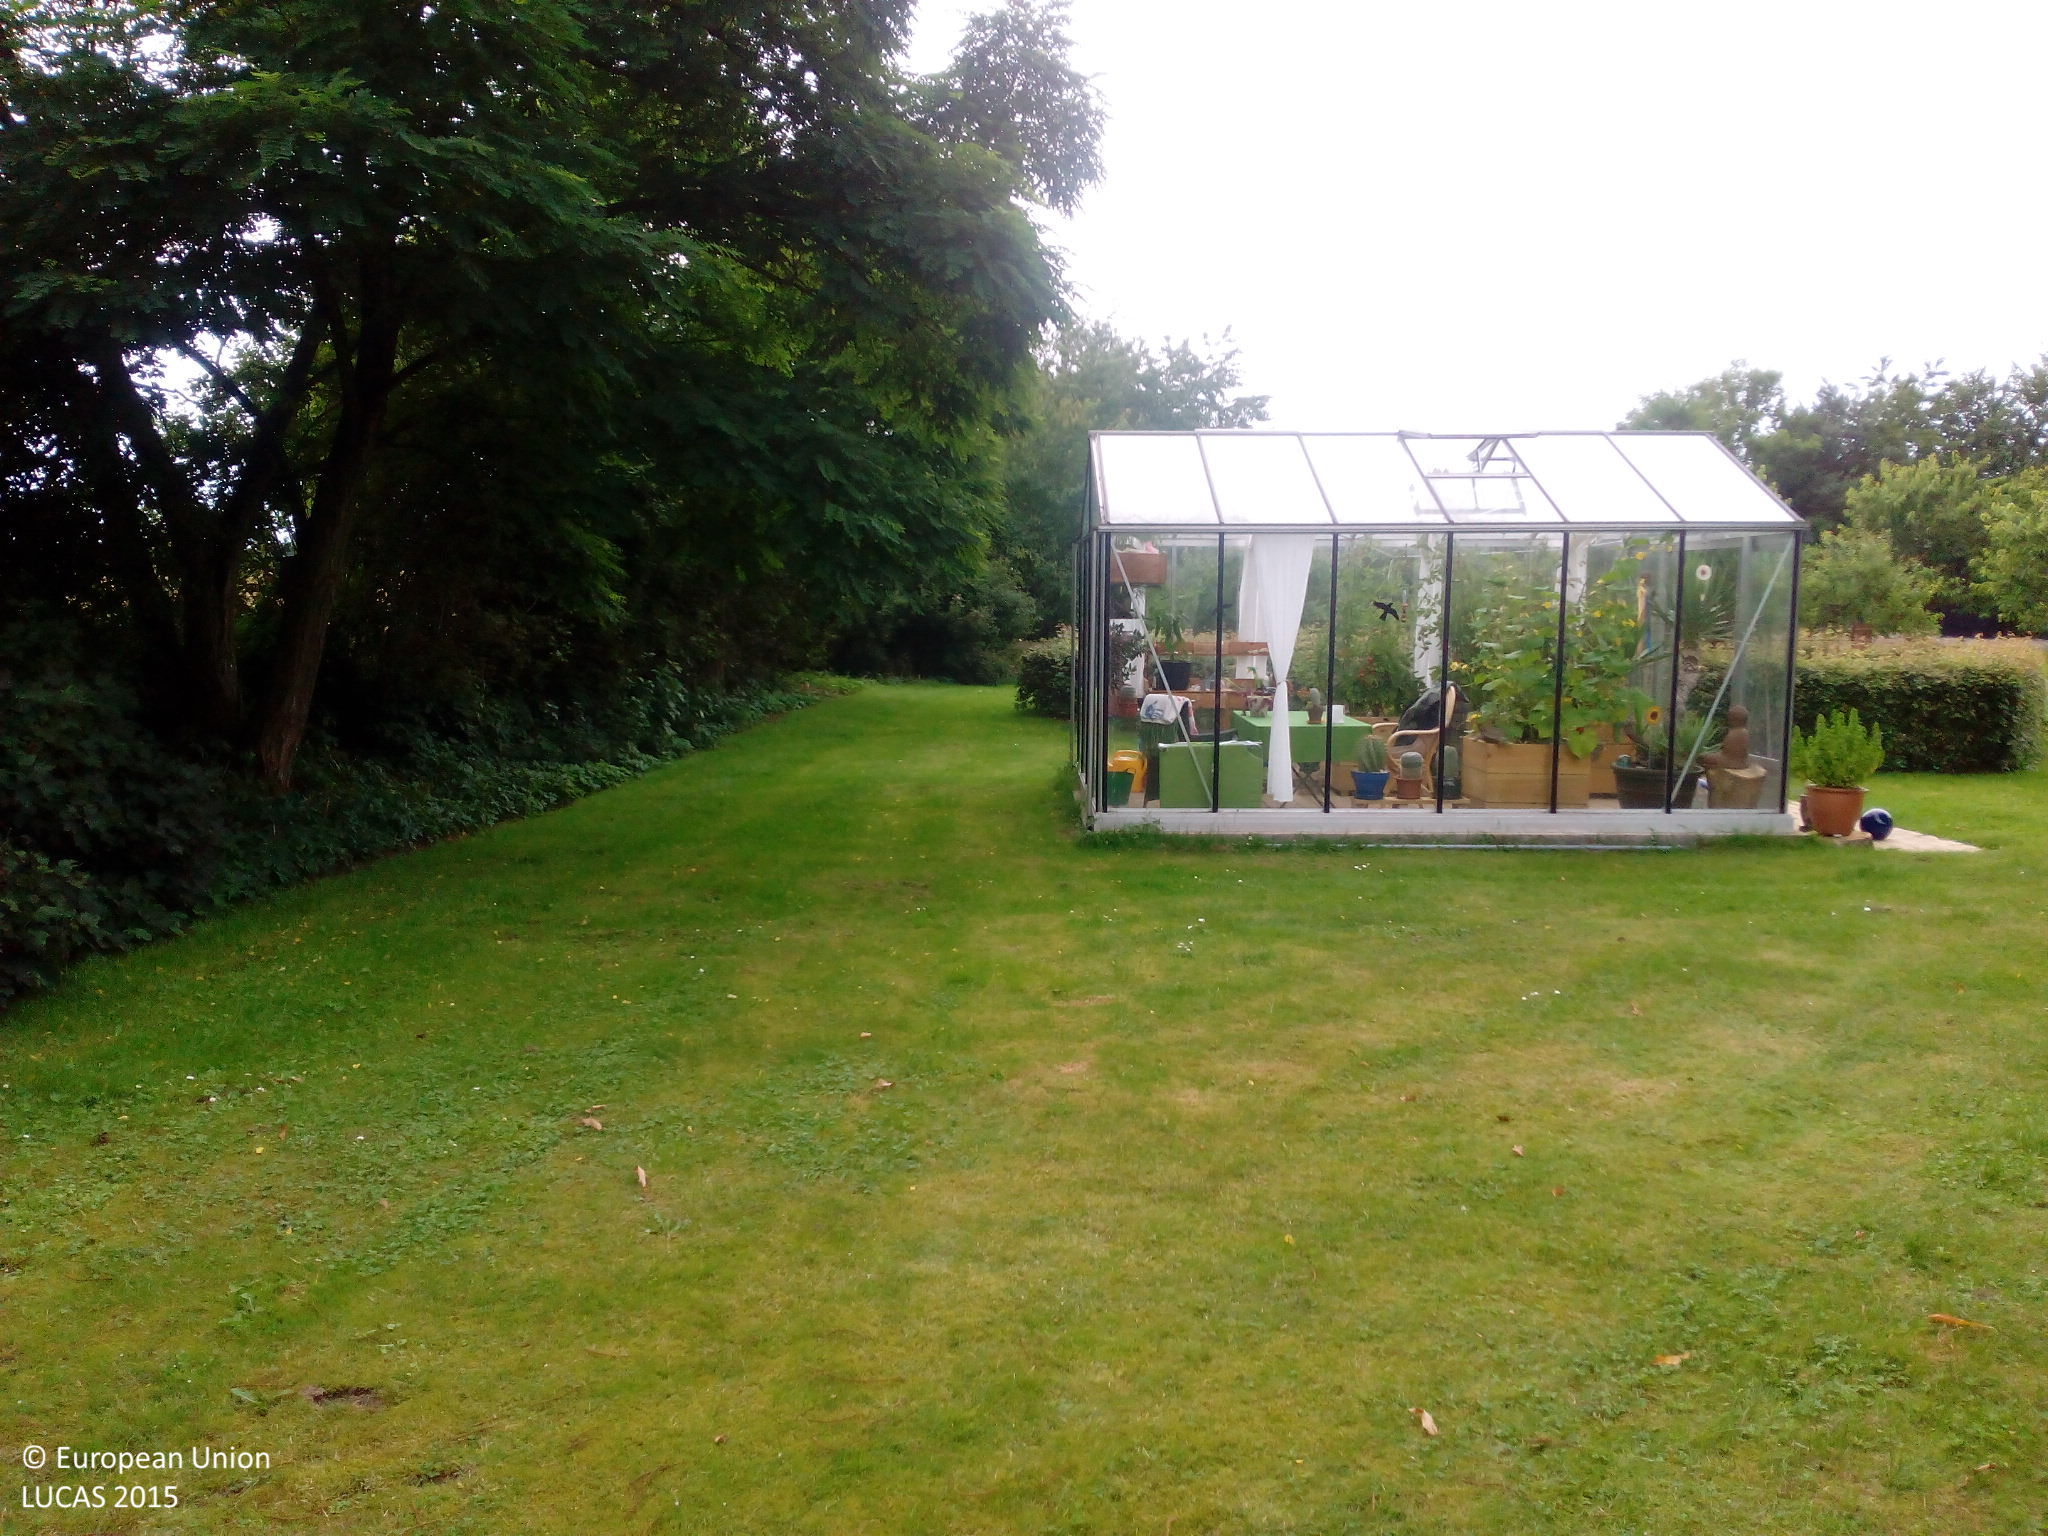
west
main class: Woodland
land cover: Broadleaved woodland
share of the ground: 10 - 25 %
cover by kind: herbaceous plants 85 %, broadleaved forest trees 15 %
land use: Residential
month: August
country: DK
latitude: 55.5442
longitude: 11.9160
